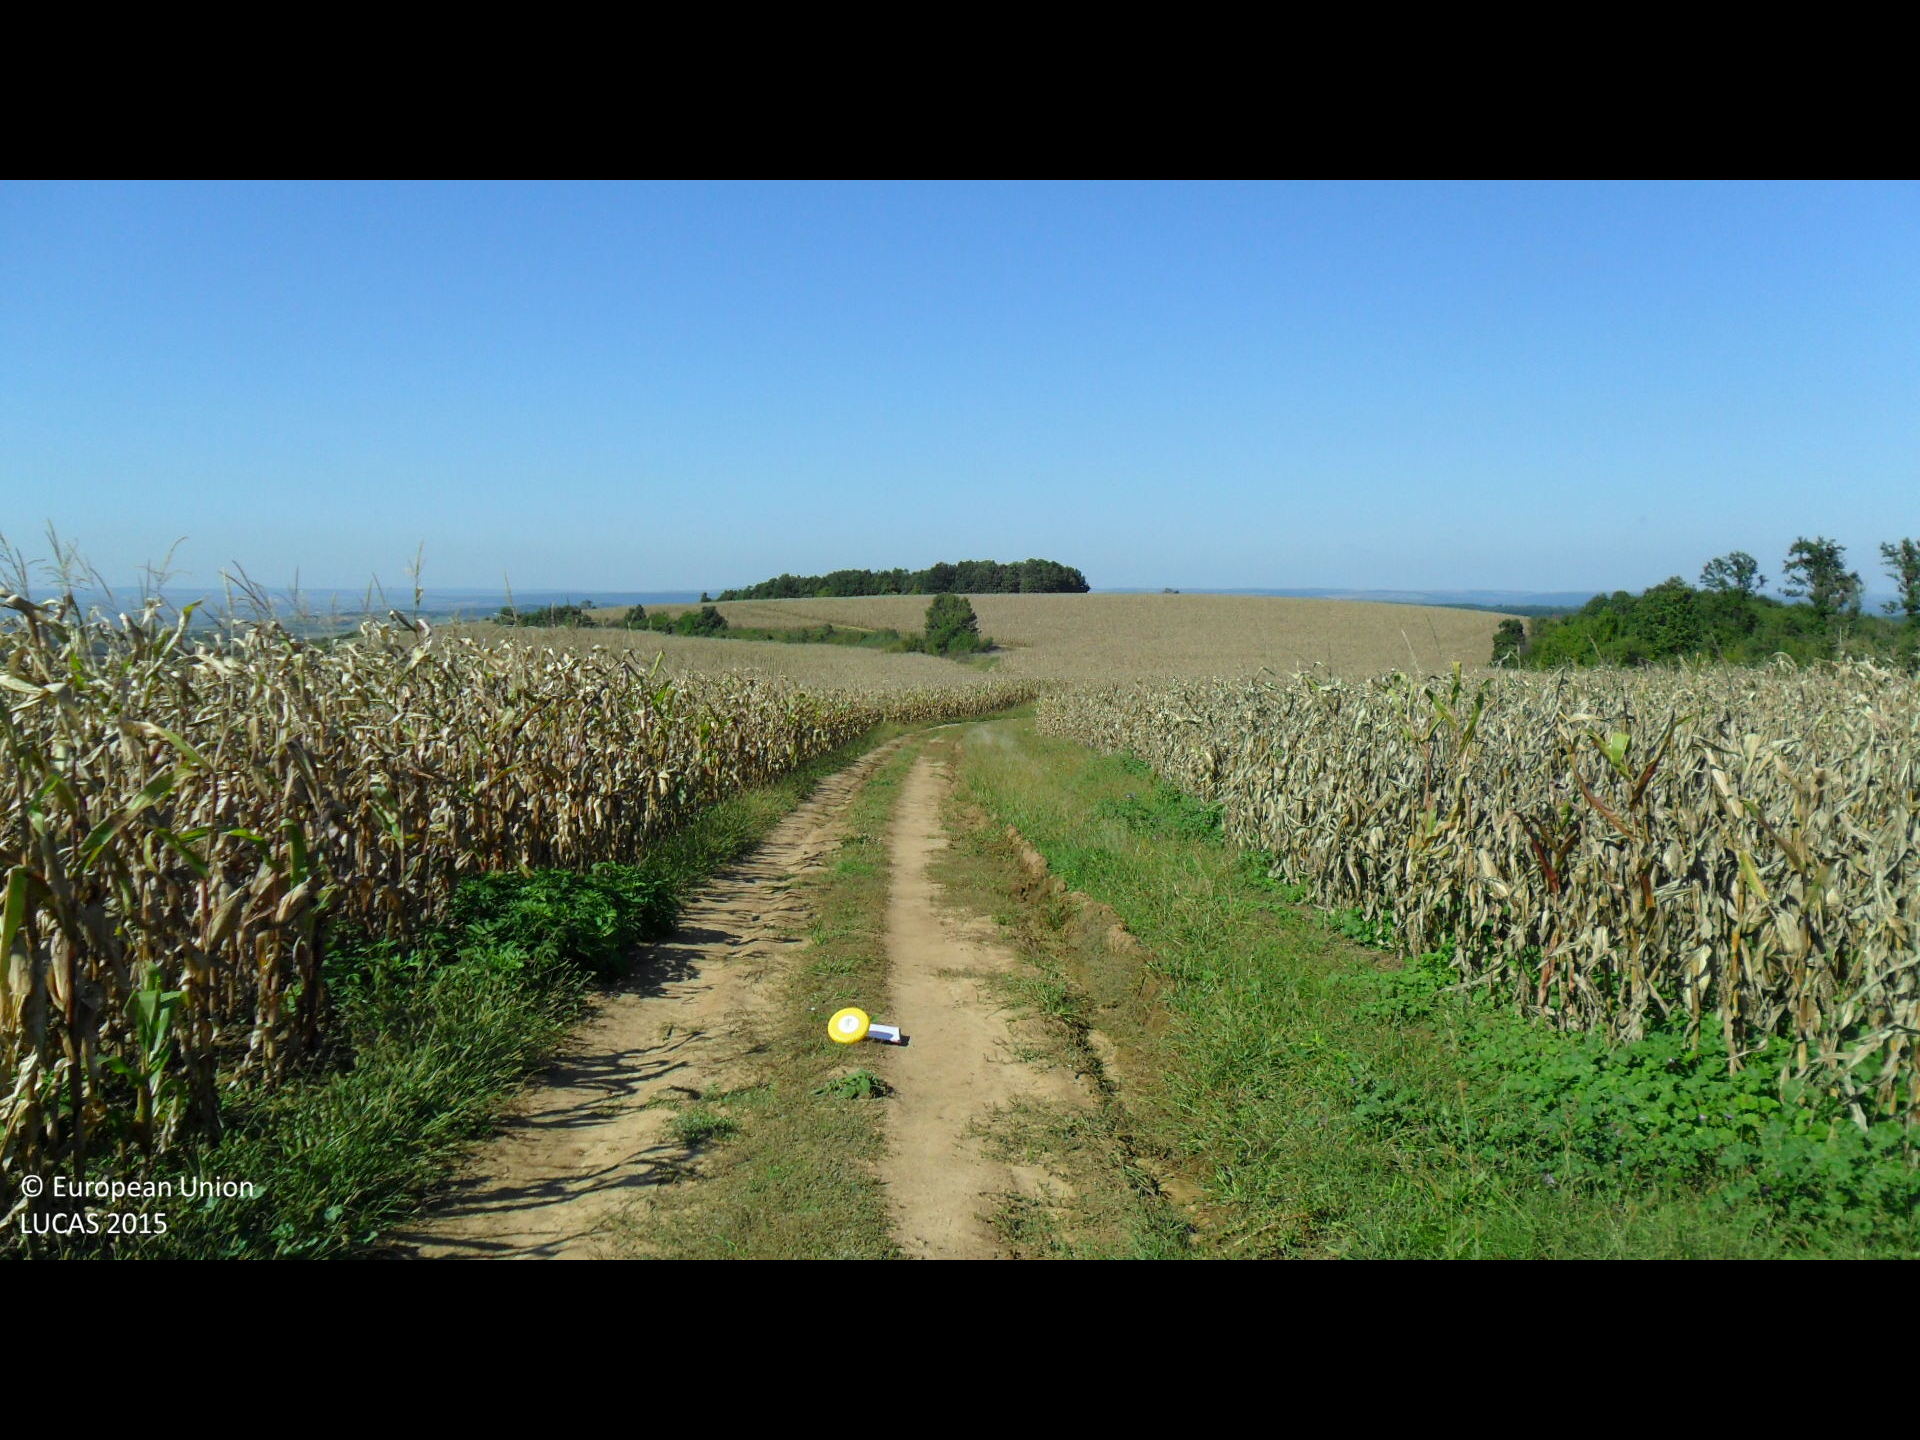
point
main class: Cropland
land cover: Maize
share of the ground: > 75 %
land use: Agriculture (excluding fallow land and kitchen gardens)
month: October
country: BG
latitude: 43.1407
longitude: 26.0861
